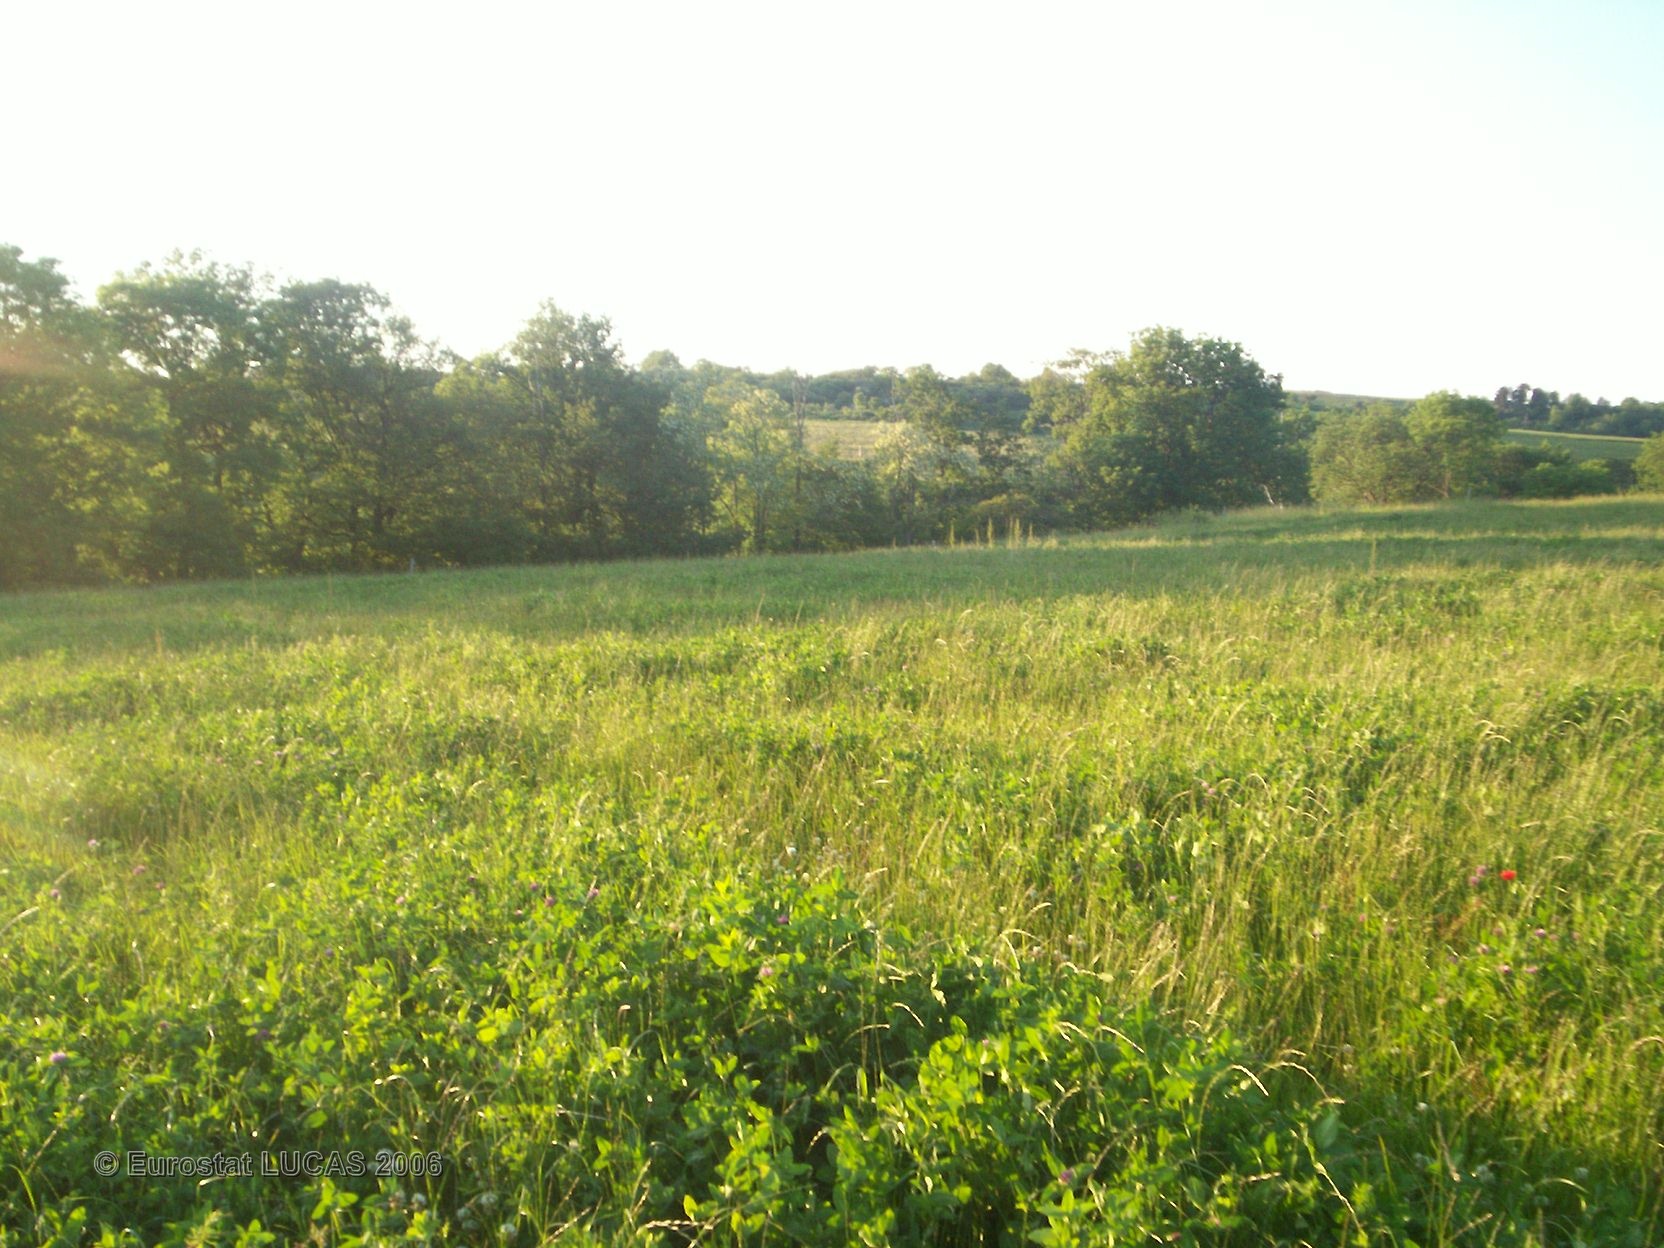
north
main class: Cropland
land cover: Other leguminous and mixtures for fodder
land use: Agriculture (excluding fallow land and kitchen gardens)
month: June
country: FR
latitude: 46.0762
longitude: 3.1330
